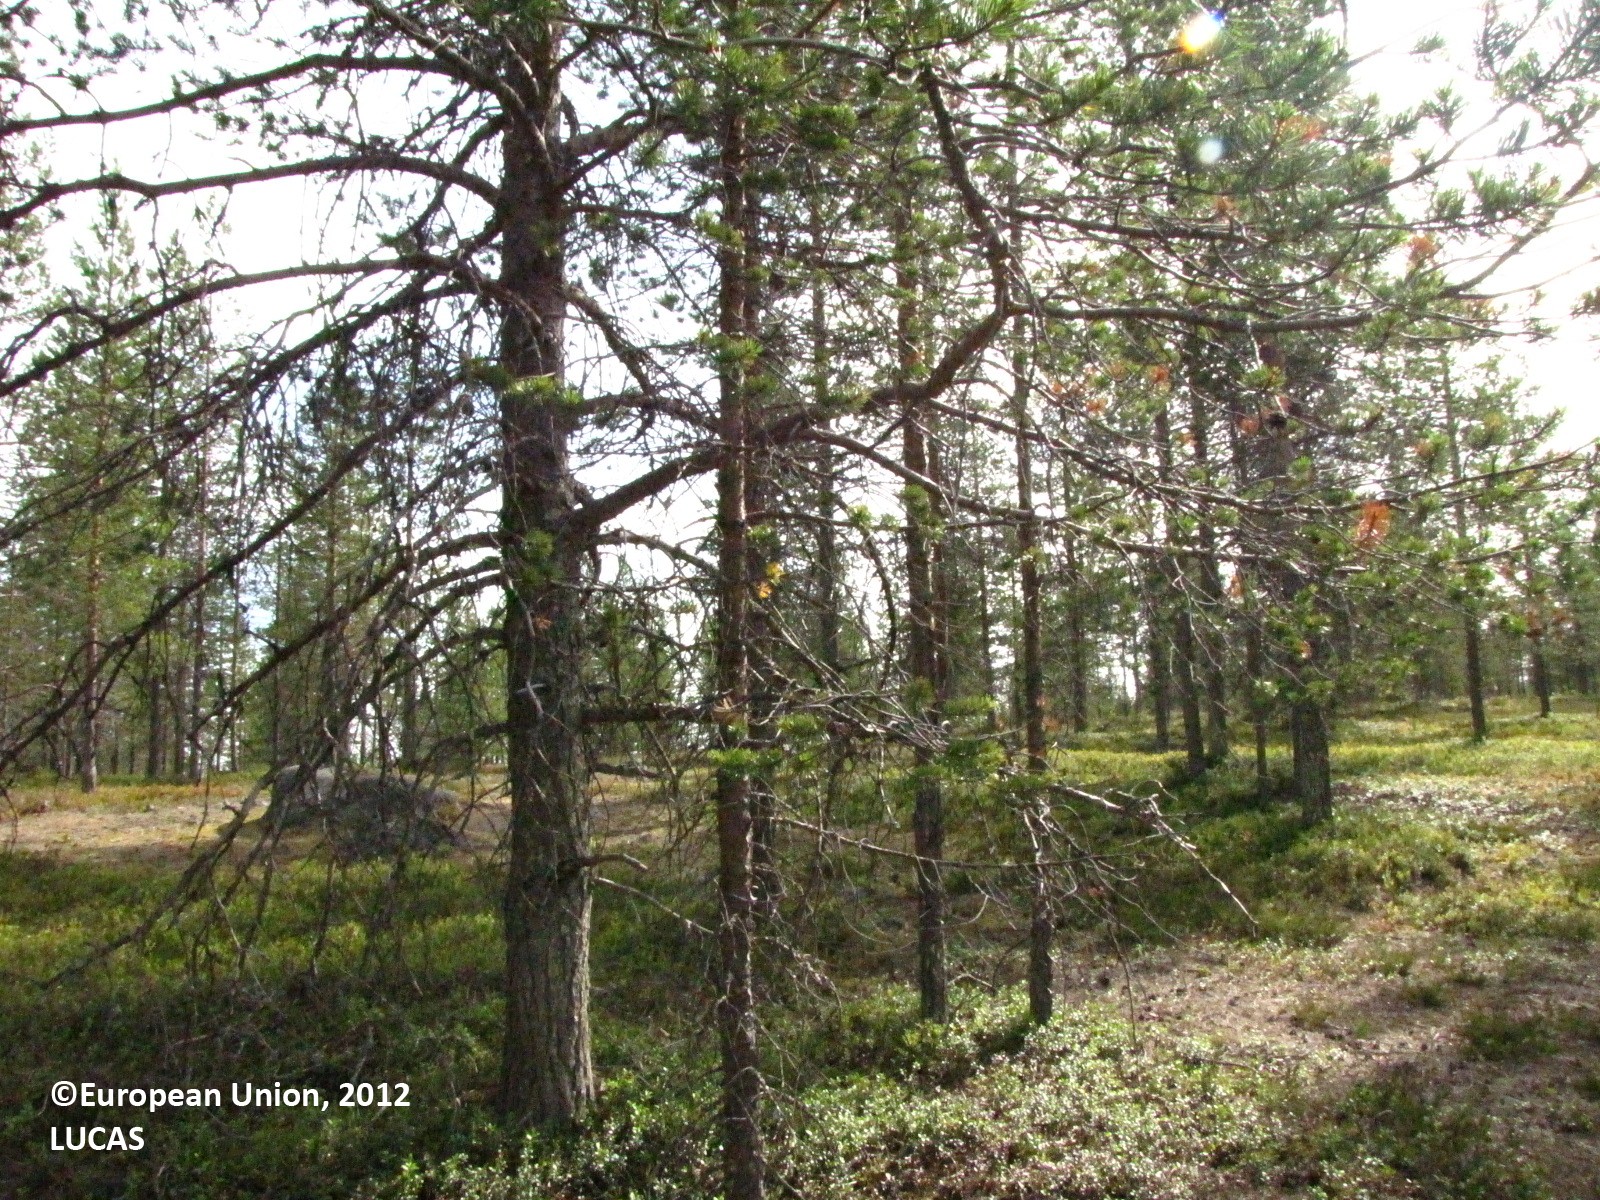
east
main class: Woodland
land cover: Pine dominated coniferous woodland
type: boreal forest
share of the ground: 50 - 75 %
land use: Forestry
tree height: > 5 m
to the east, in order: Pine dominated coniferous woodland
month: July
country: FI
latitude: 66.6439
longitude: 25.1315
